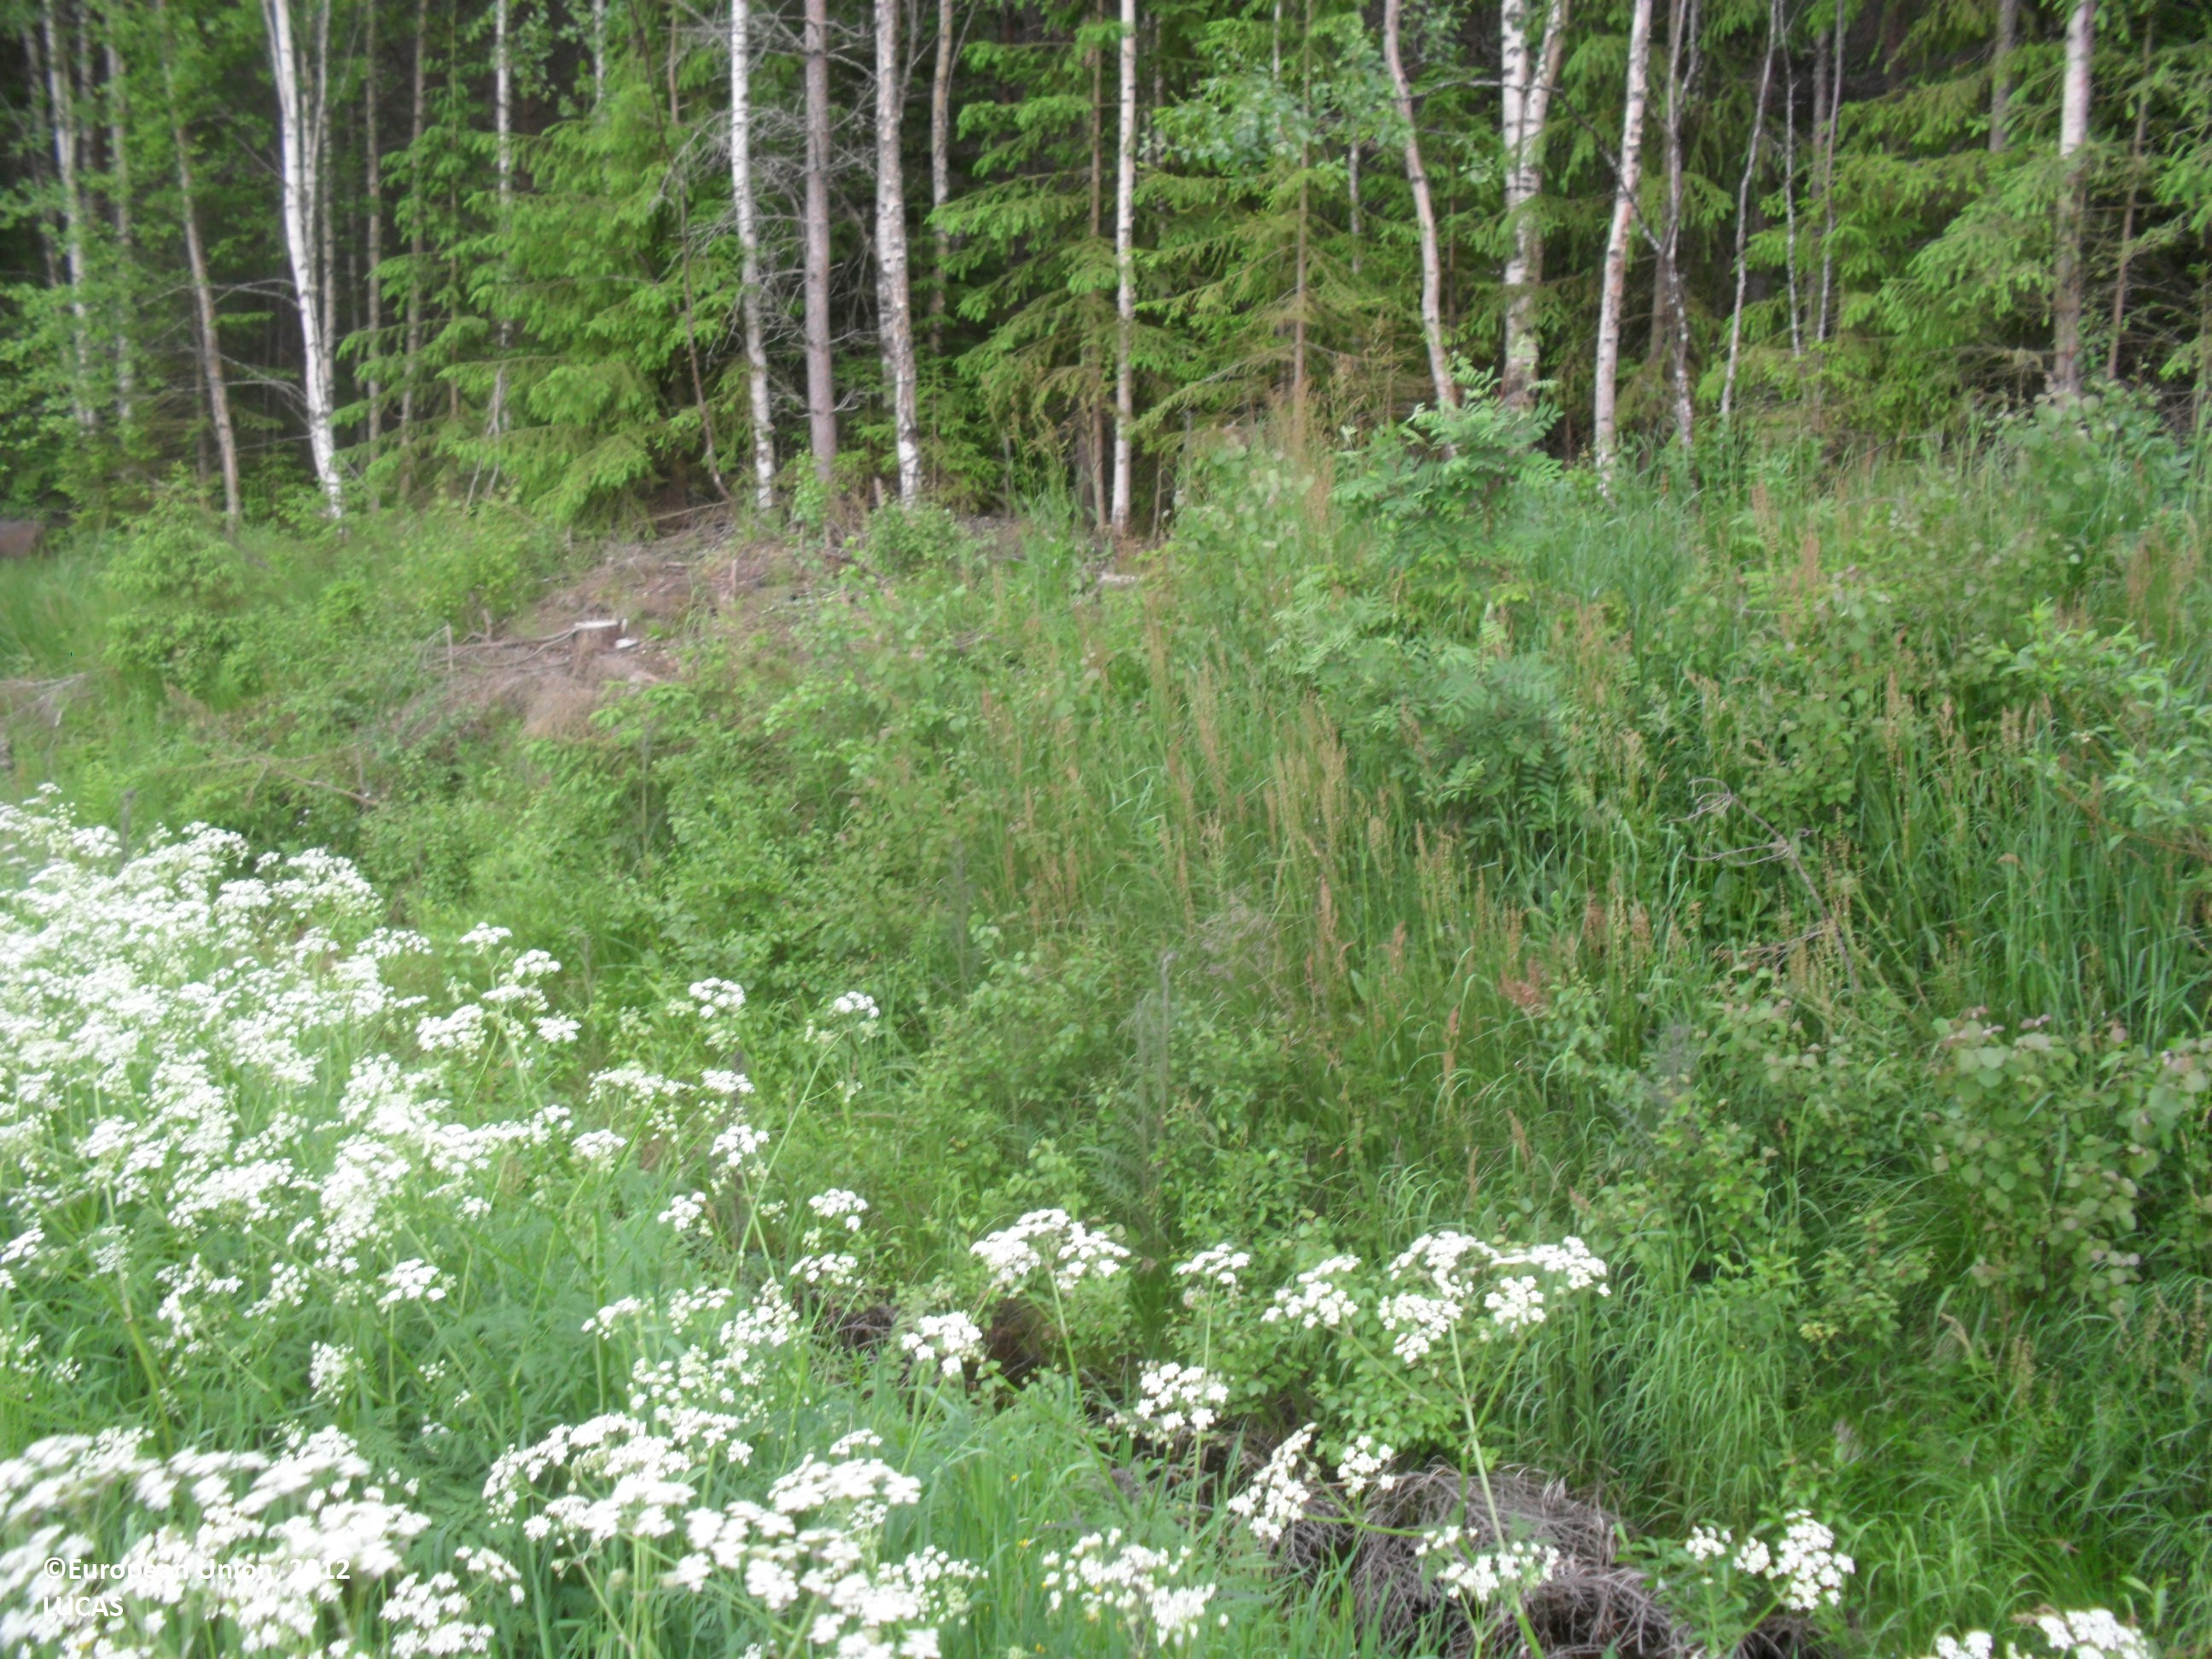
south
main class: Grassland
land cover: Grassland without tree/shrub cover
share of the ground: > 75 %
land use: Agriculture (excluding fallow land and kitchen gardens)
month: June
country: FI
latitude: 63.4831
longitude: 23.1257
